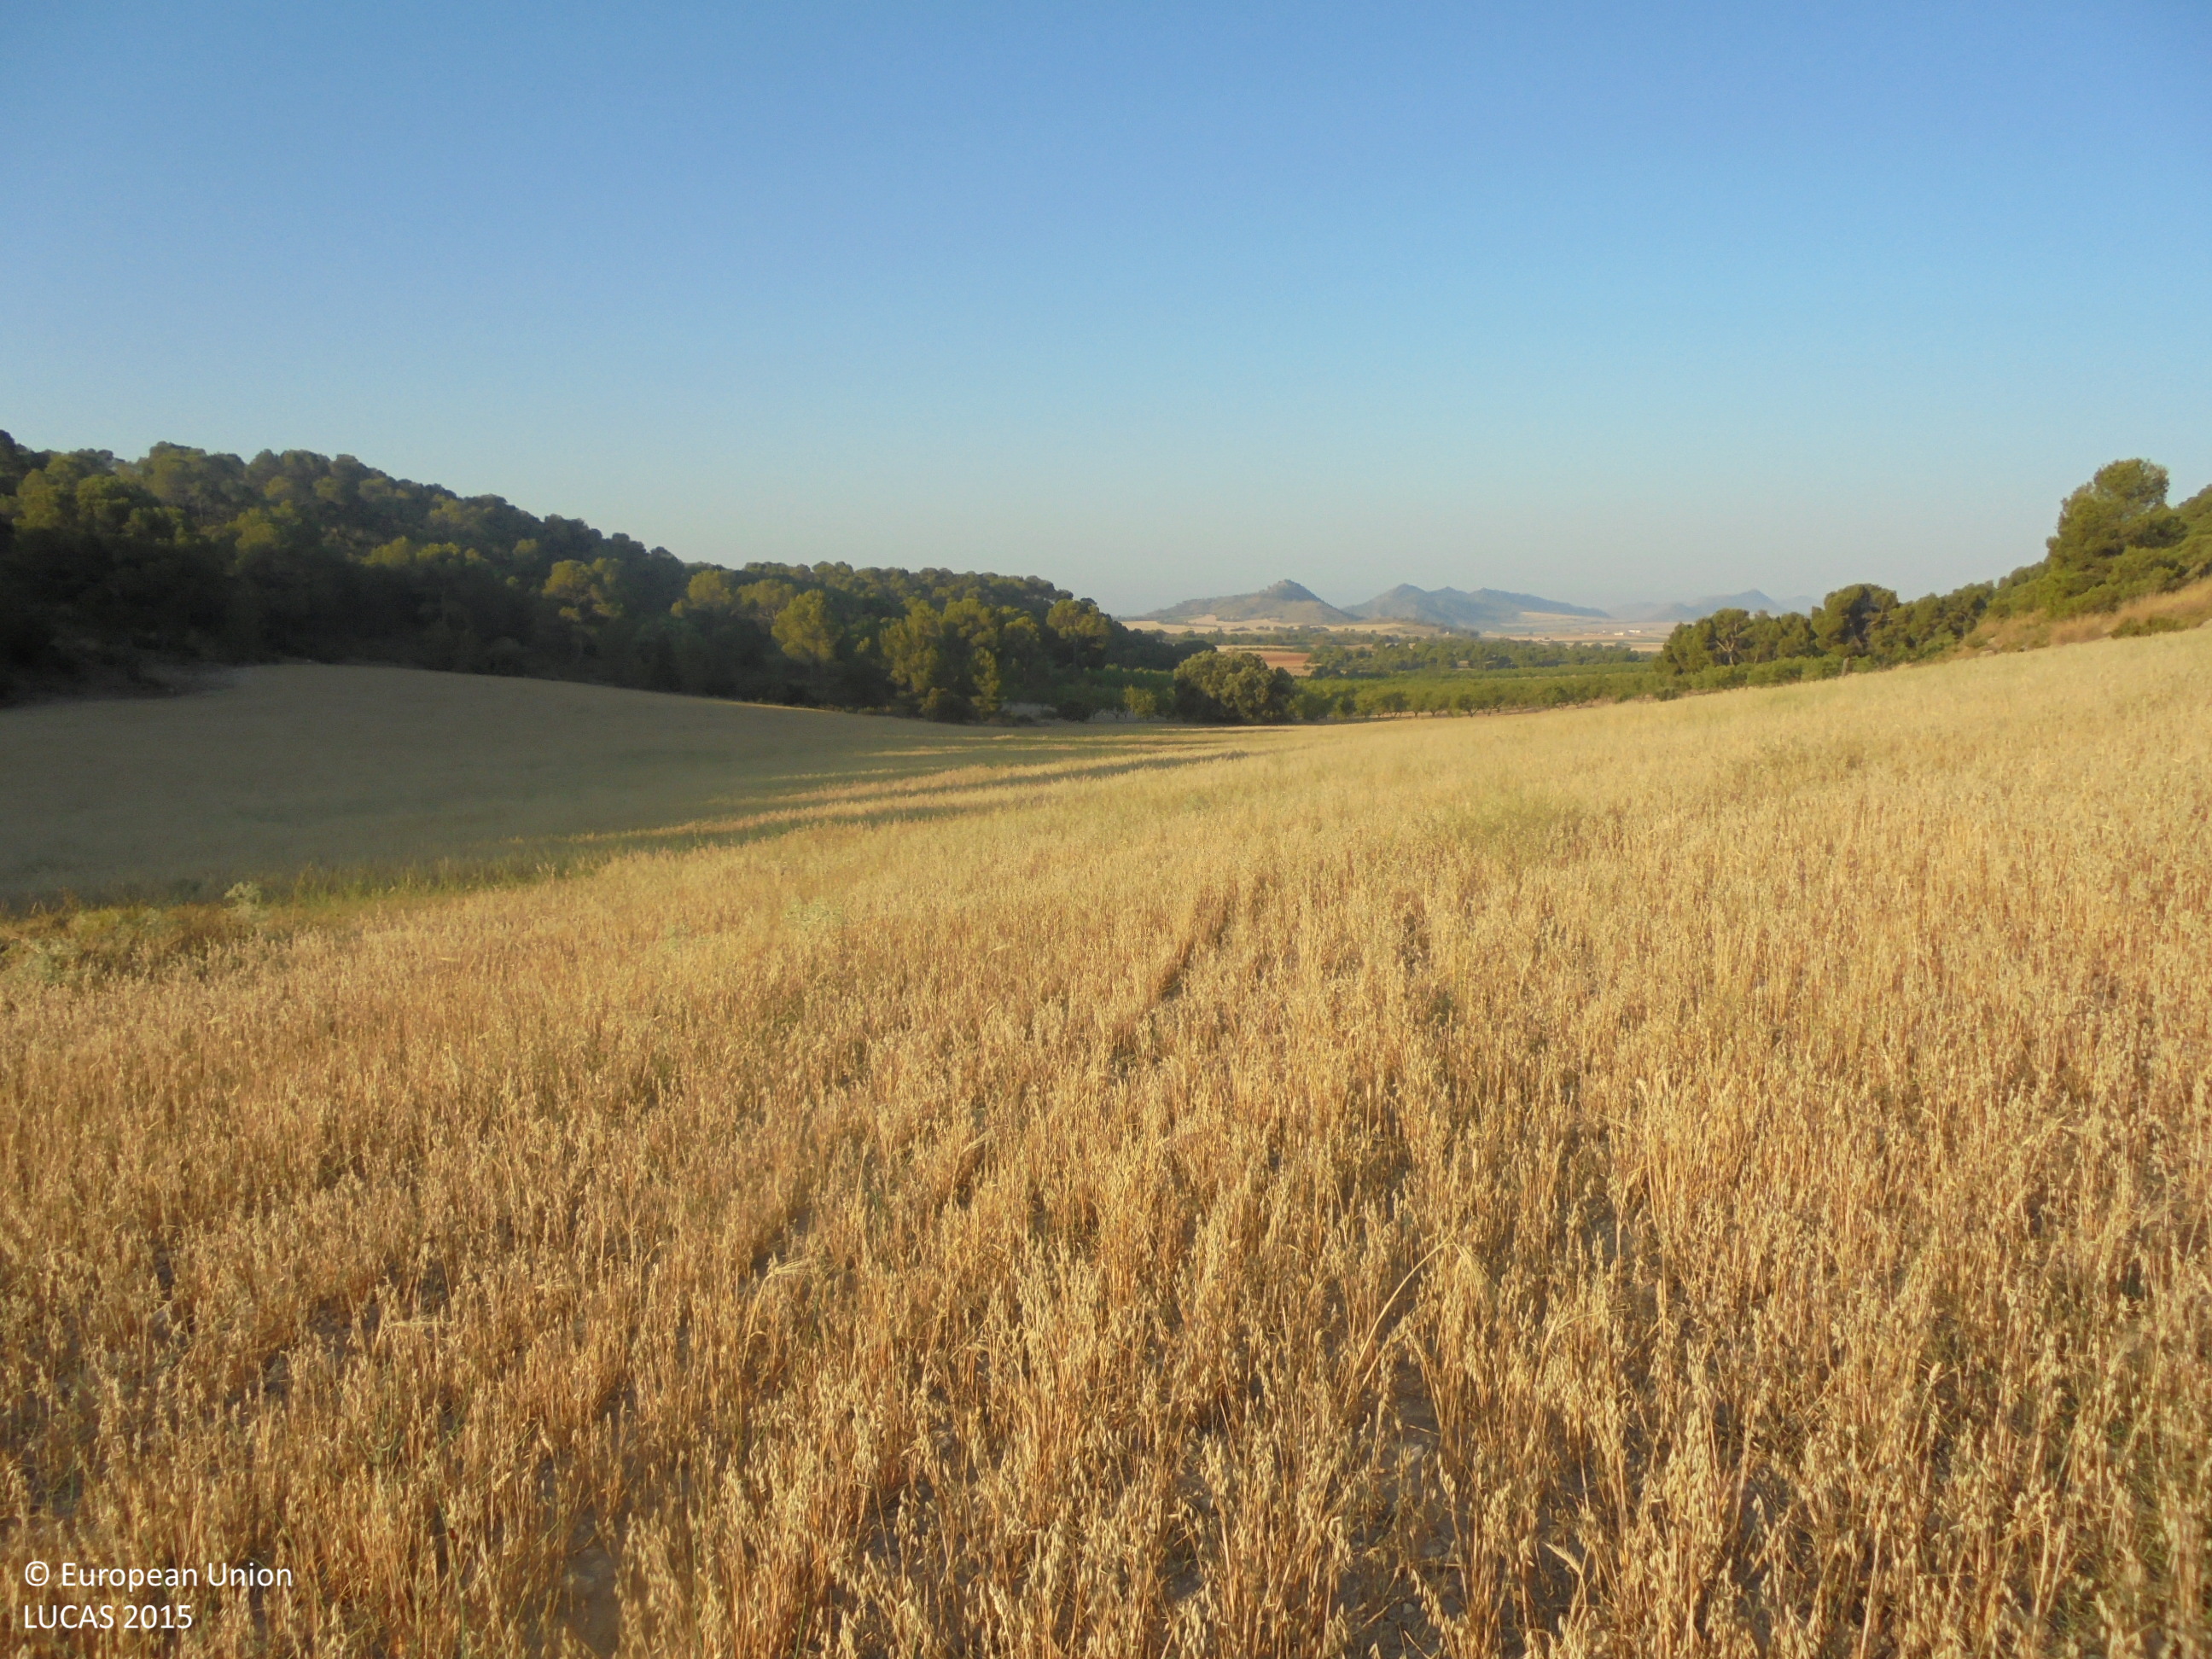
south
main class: Cropland
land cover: Oats
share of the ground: 25 - 50 %
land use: Agriculture (excluding fallow land and kitchen gardens)
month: July
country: ES
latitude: 38.7332
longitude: -1.6258
